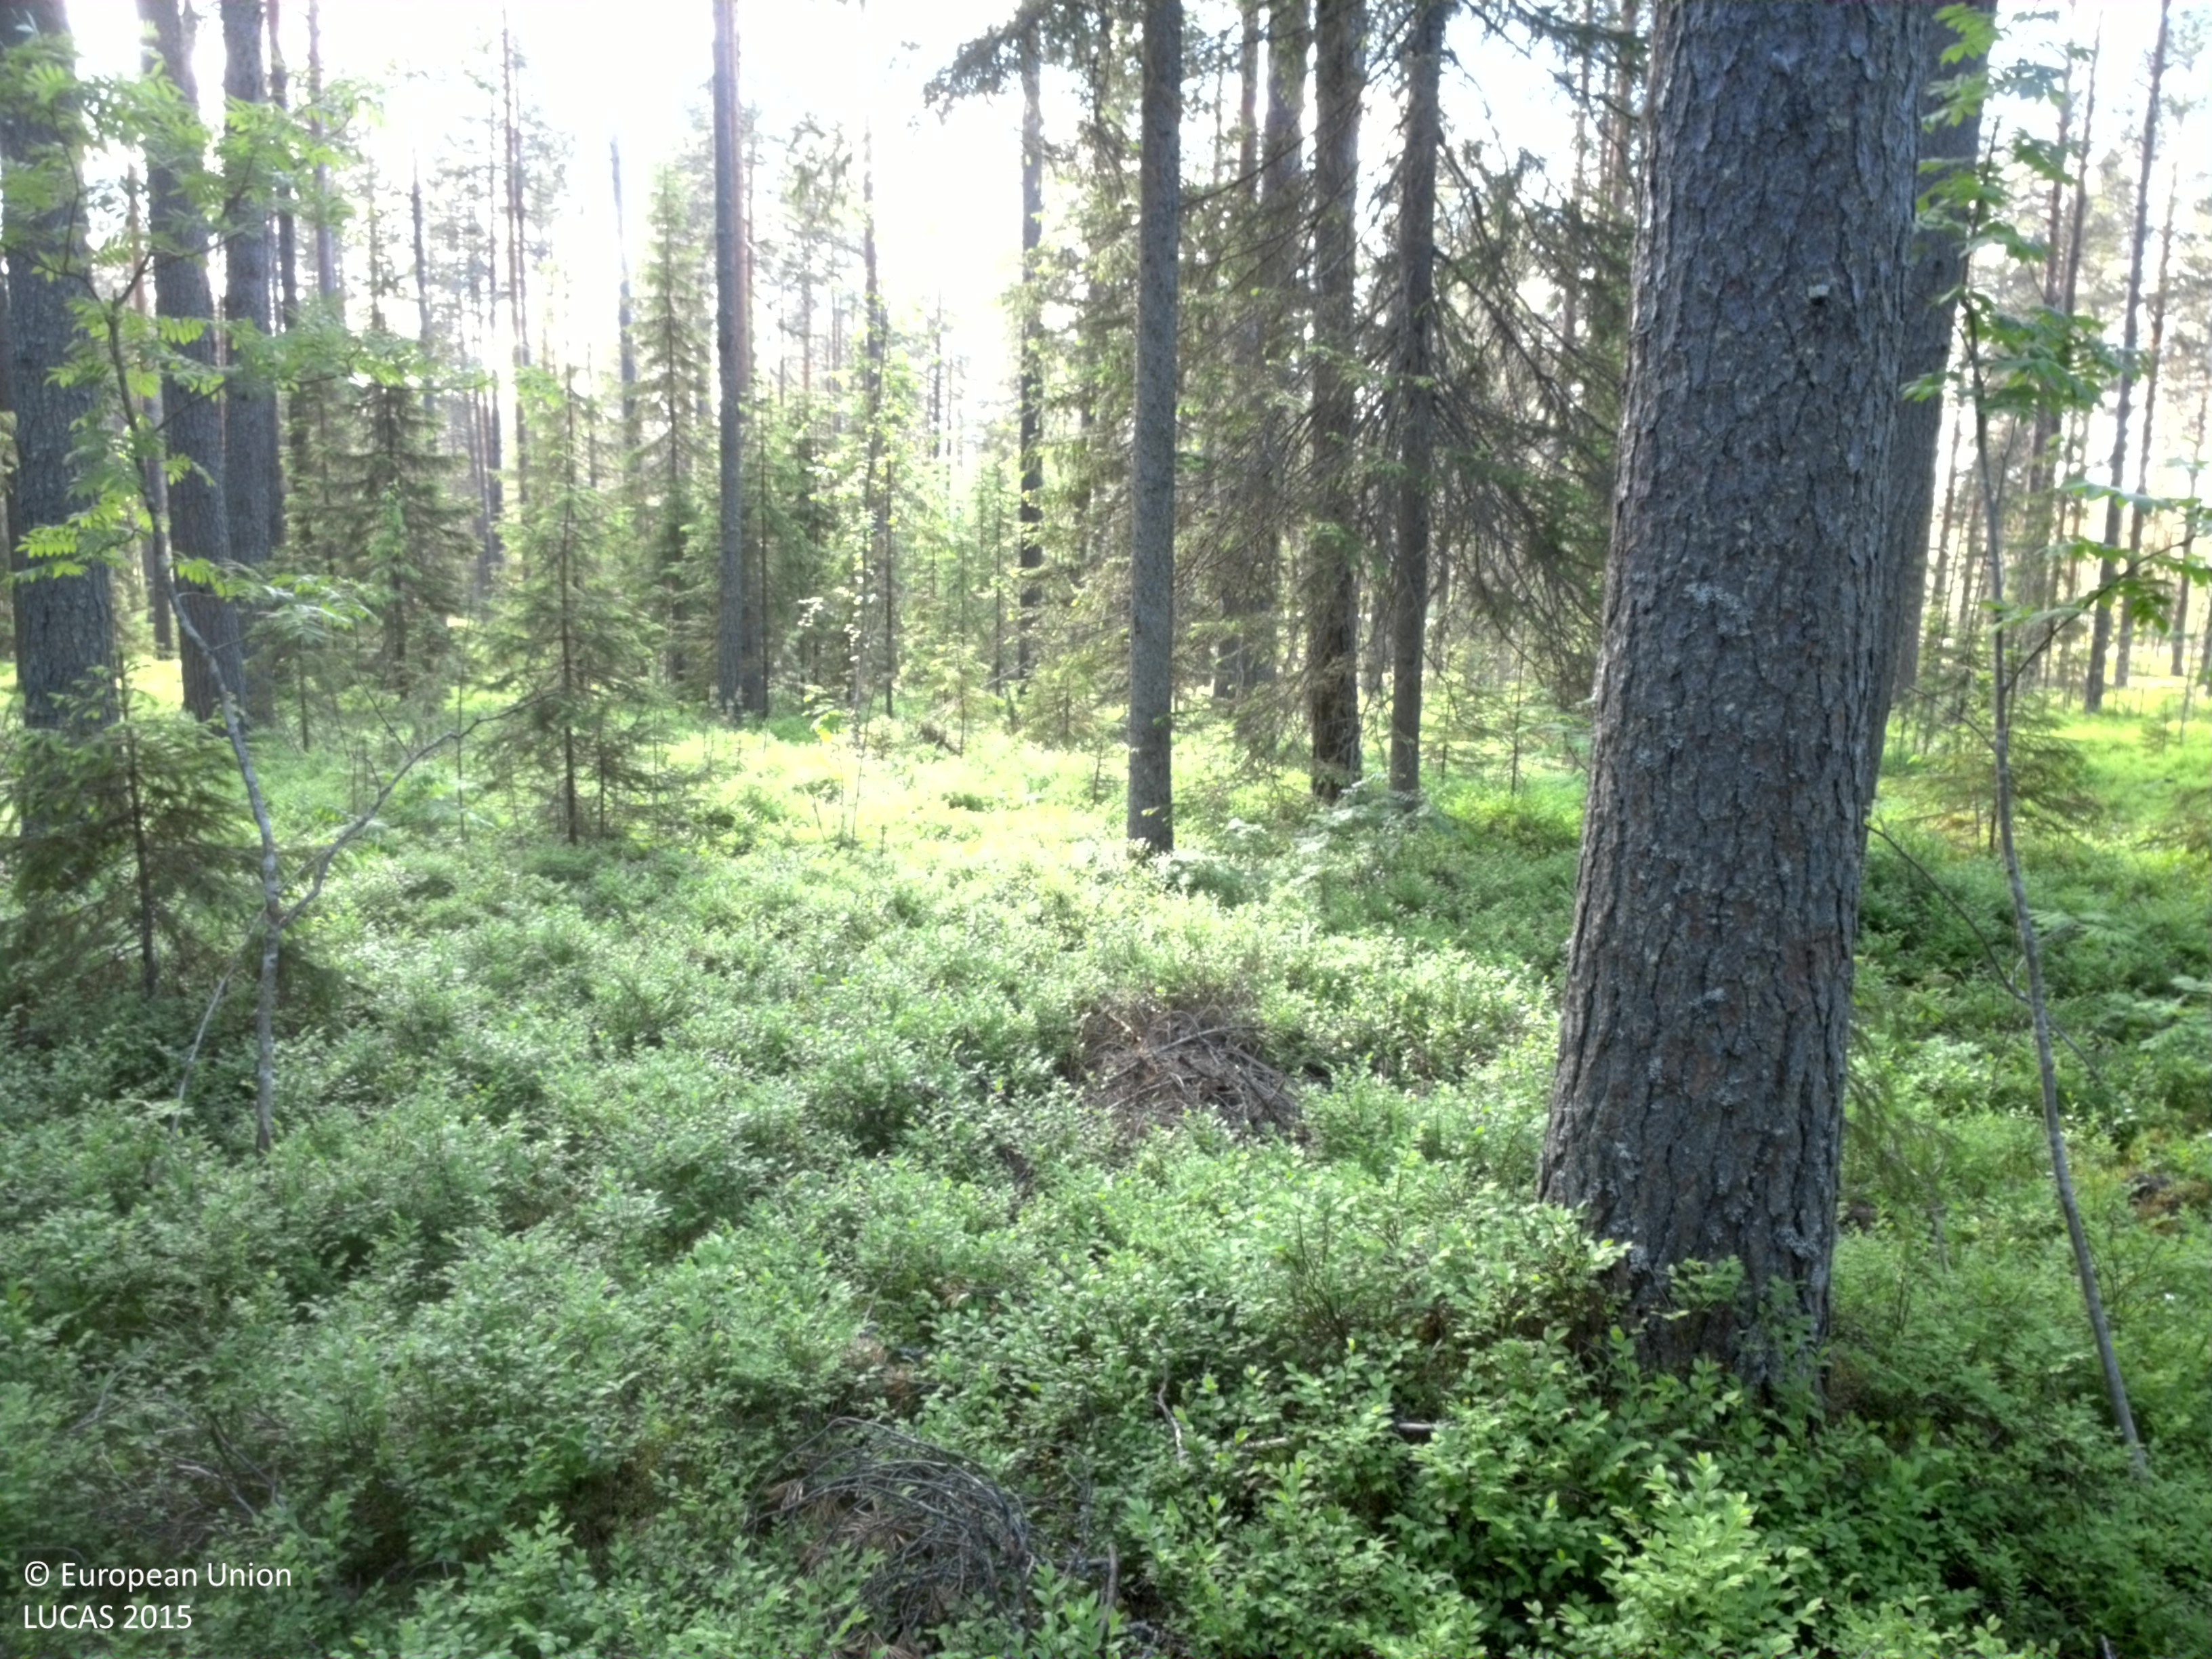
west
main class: Woodland
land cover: Pine dominated coniferous woodland
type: boreal forest
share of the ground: 25 - 50 %
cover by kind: shrubs 60 %, coniferous forest trees 40 %
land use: Forestry
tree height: > 5 m
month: June
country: SE
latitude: 66.3229
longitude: 22.7639
